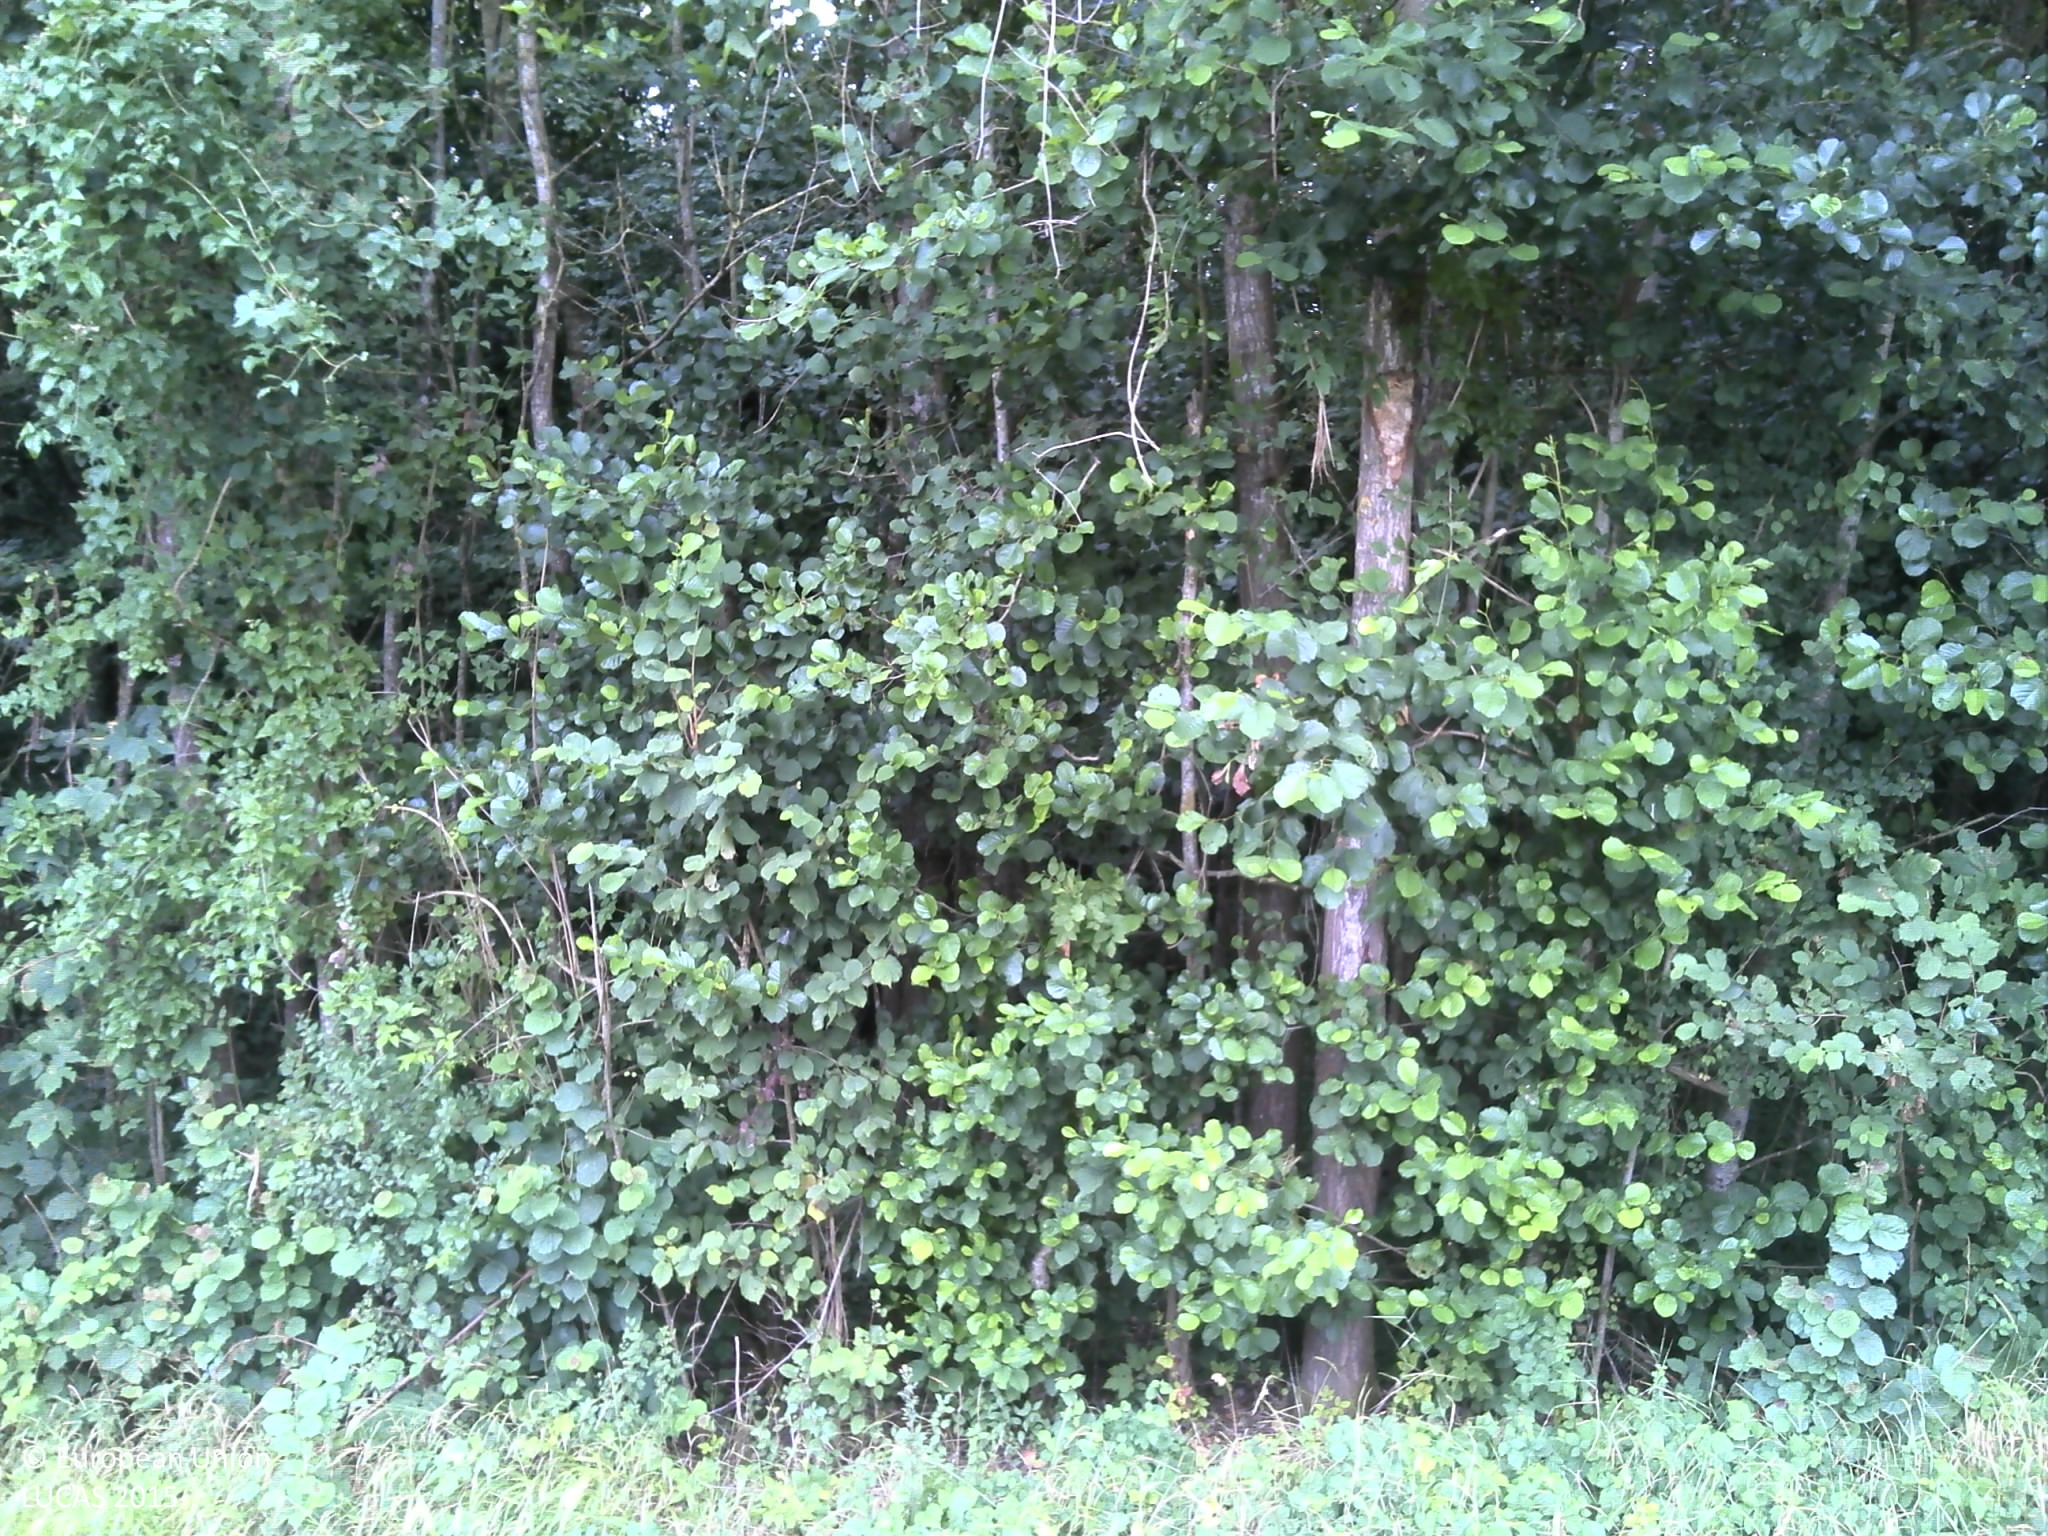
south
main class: Cropland
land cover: Maize
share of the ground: > 75 %
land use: Agriculture (excluding fallow land and kitchen gardens)
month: July
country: FR
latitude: 49.5830
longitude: 4.1444
